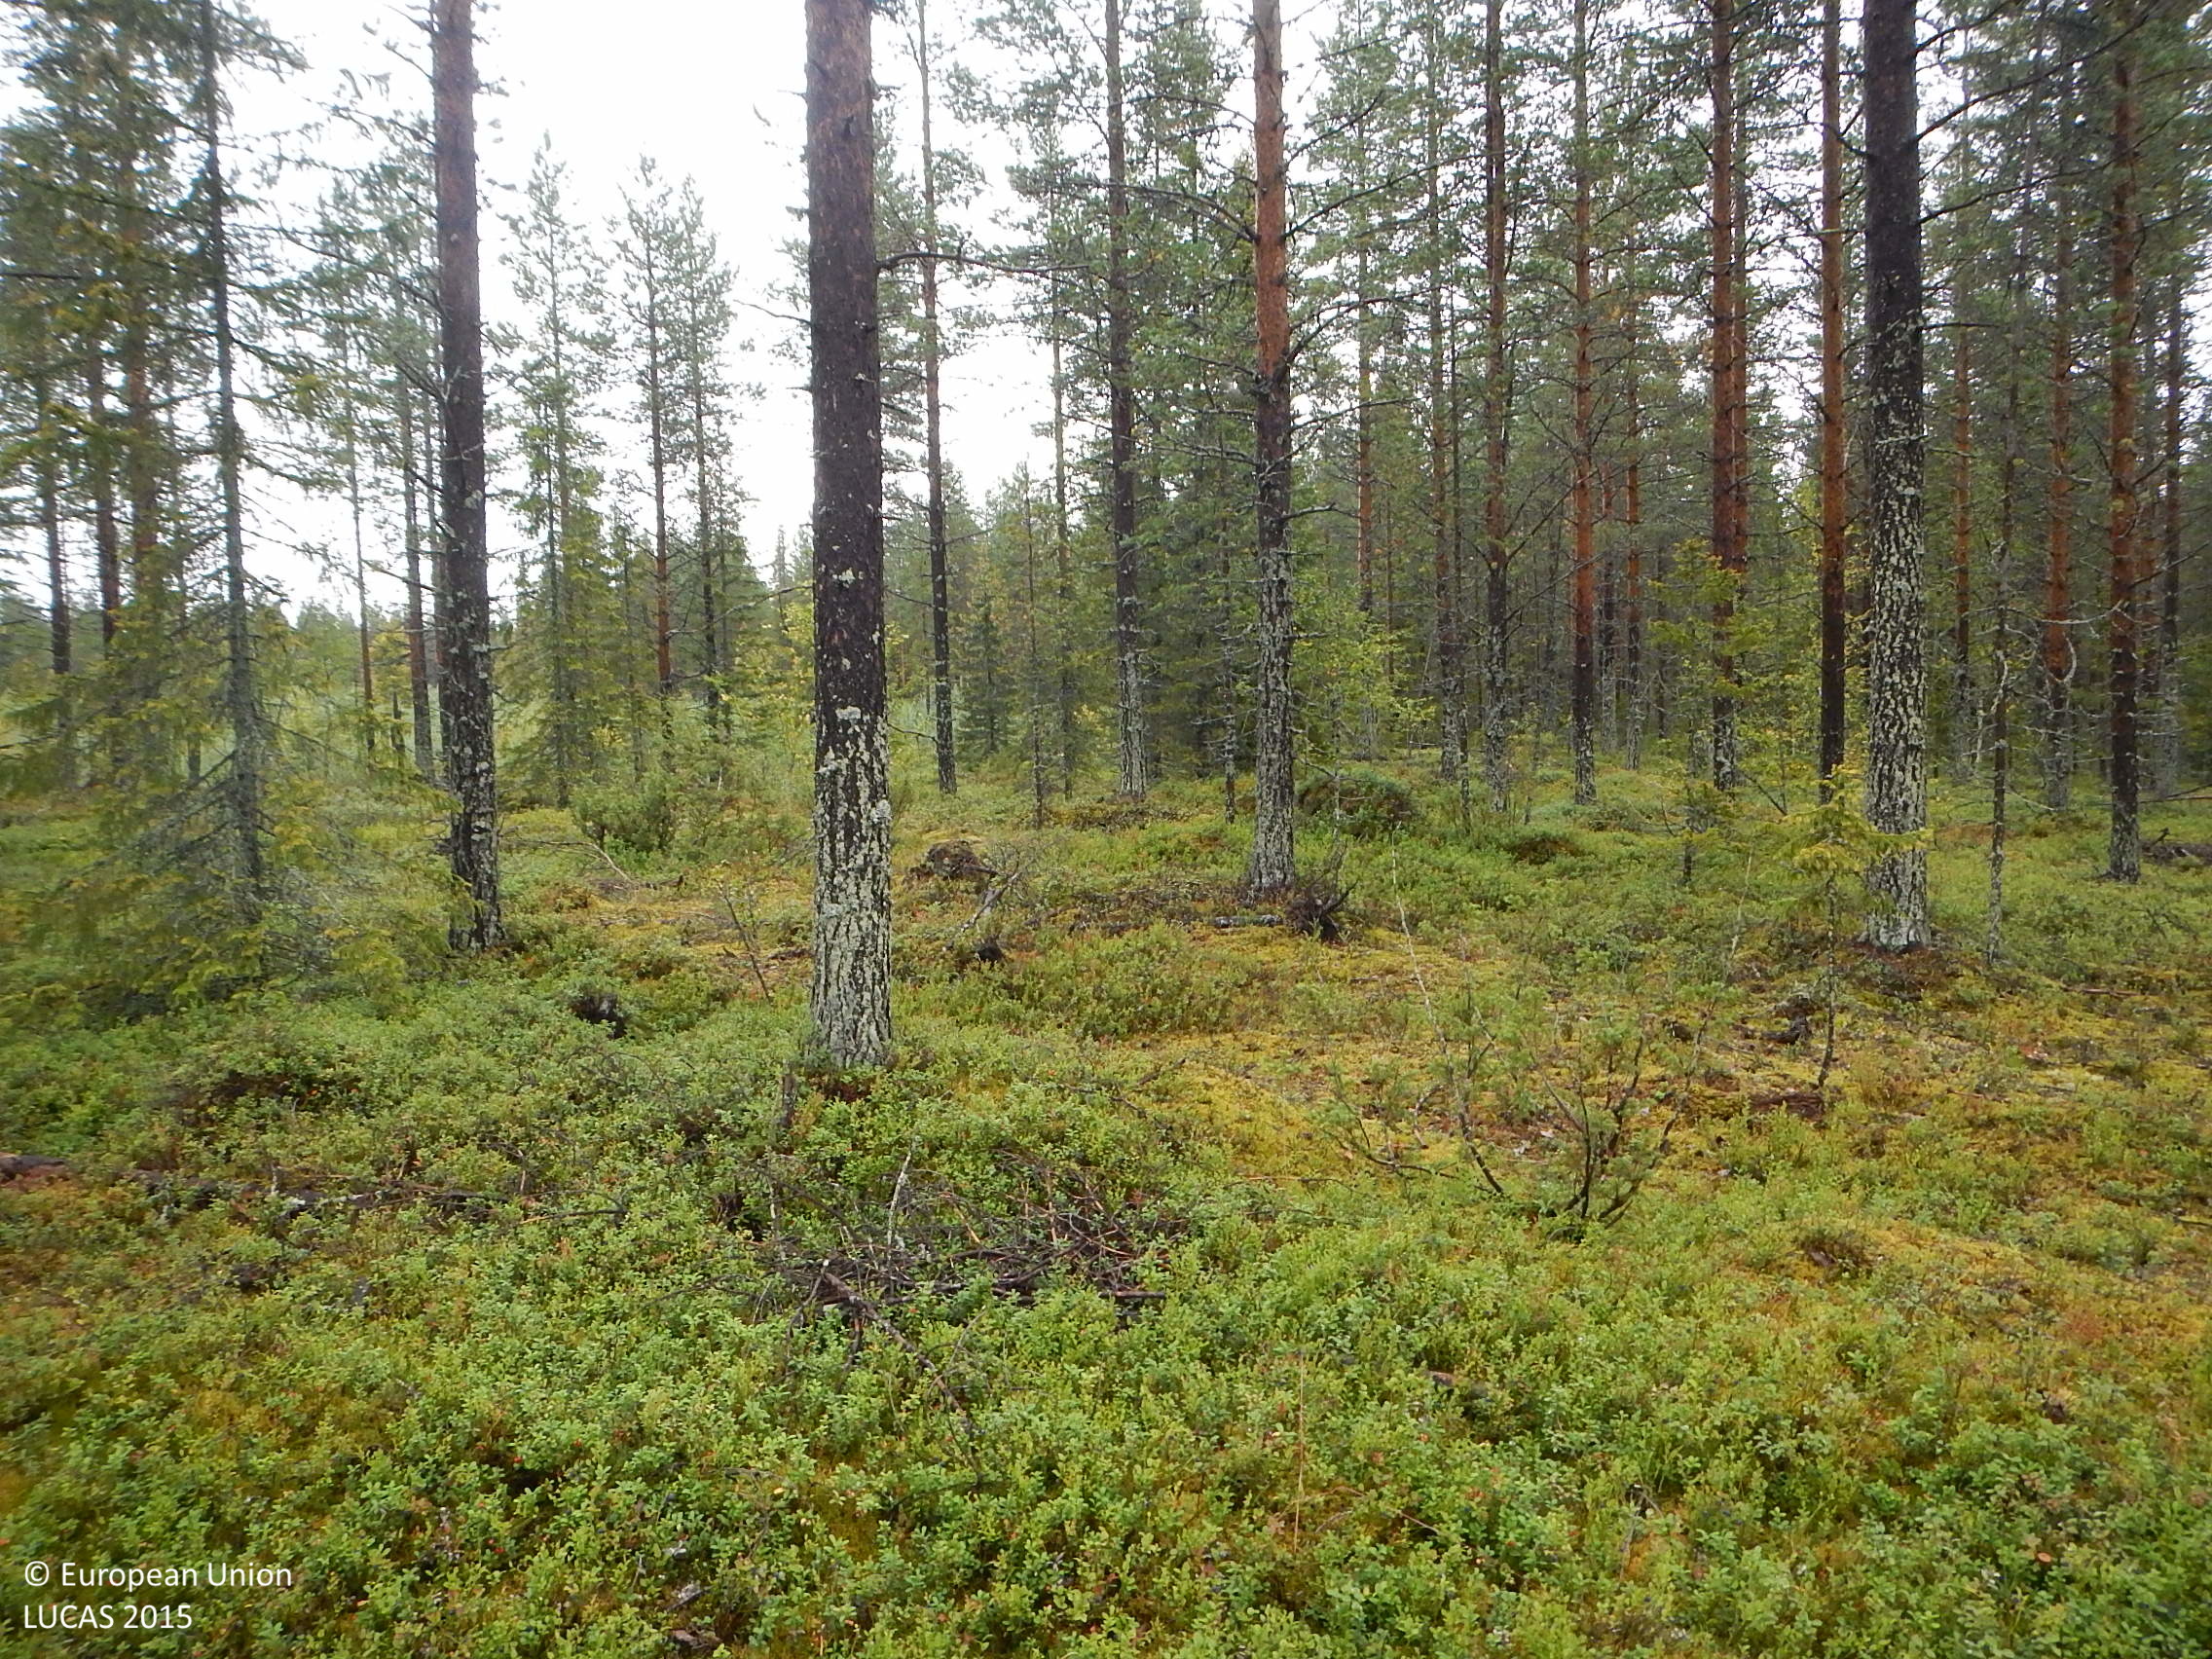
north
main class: Woodland
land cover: Pine dominated coniferous woodland
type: boreal forest
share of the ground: 50 - 75 %
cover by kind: coniferous forest trees 70 %, shrubs 25 %, lichens and mosses 5 %
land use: Forestry
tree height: > 5 m
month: August
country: FI
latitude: 65.7764
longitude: 26.9948
